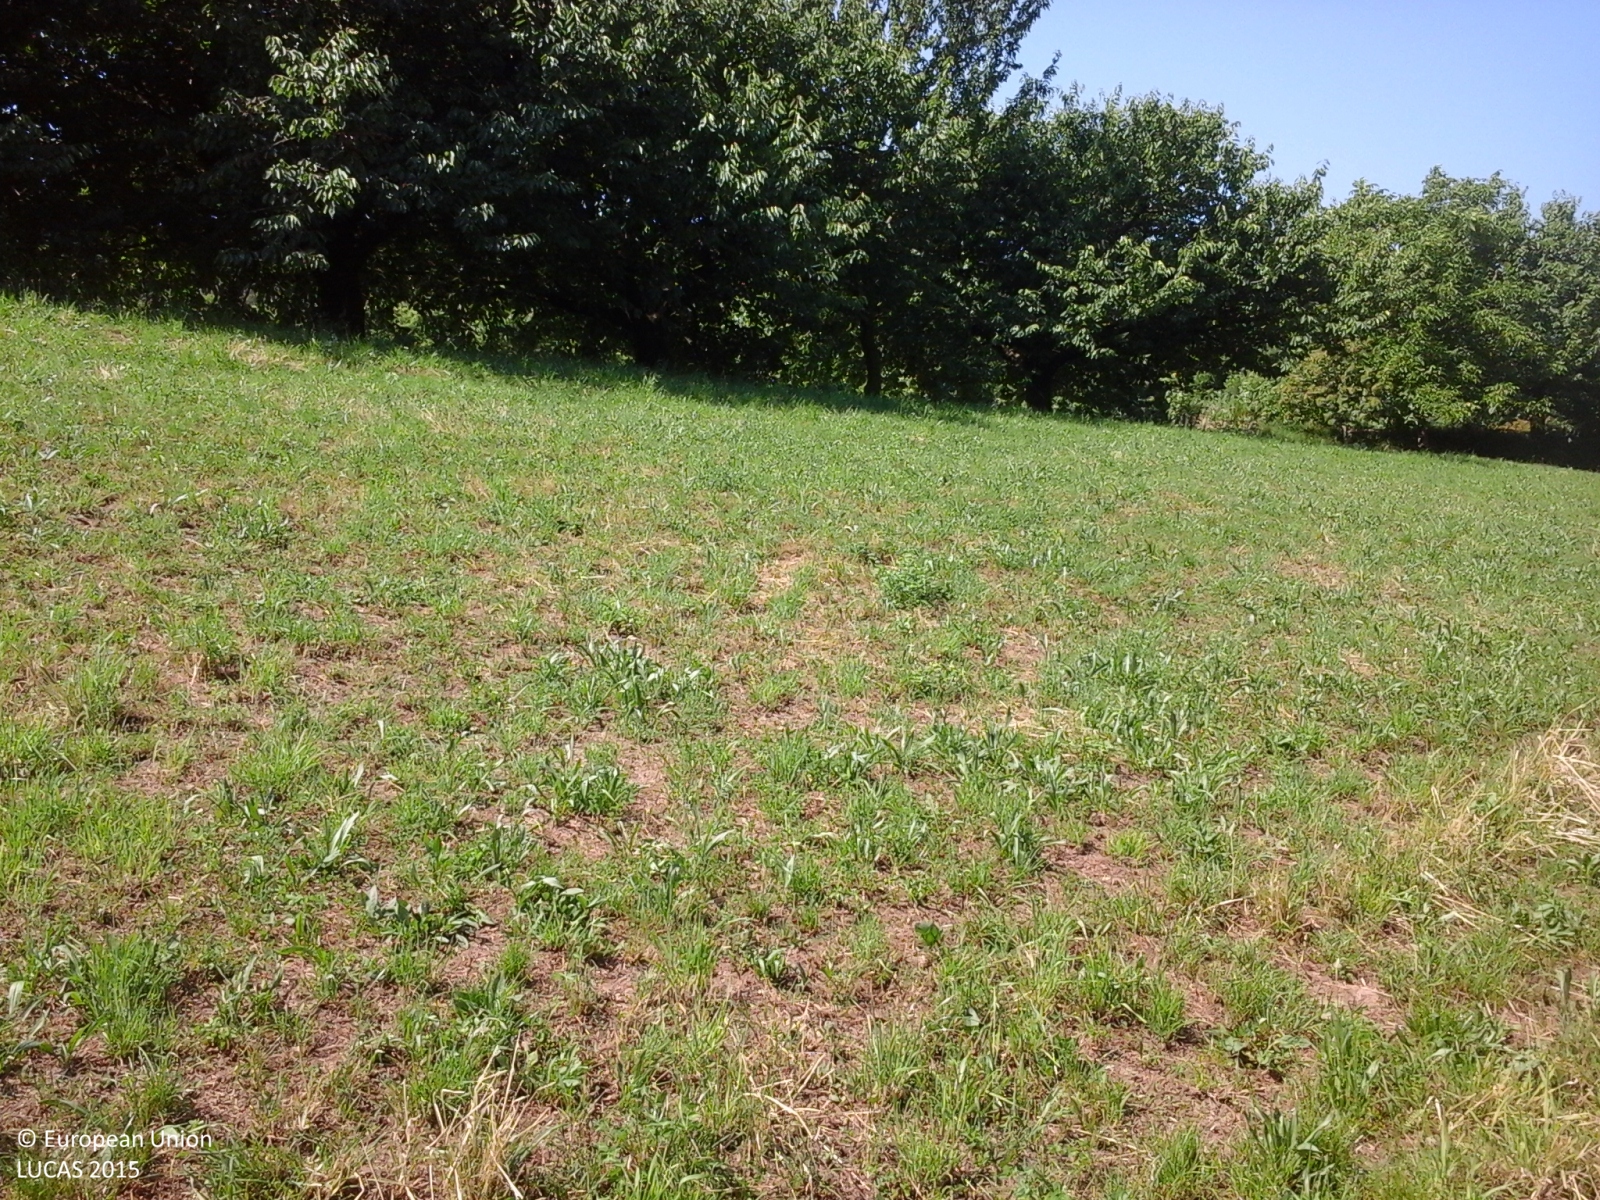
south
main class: Grassland
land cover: Grassland without tree/shrub cover
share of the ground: > 75 %
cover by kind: herbaceous plants 100 %
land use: Agriculture (excluding fallow land and kitchen gardens)
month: June
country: IT
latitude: 45.5920
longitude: 10.7294
